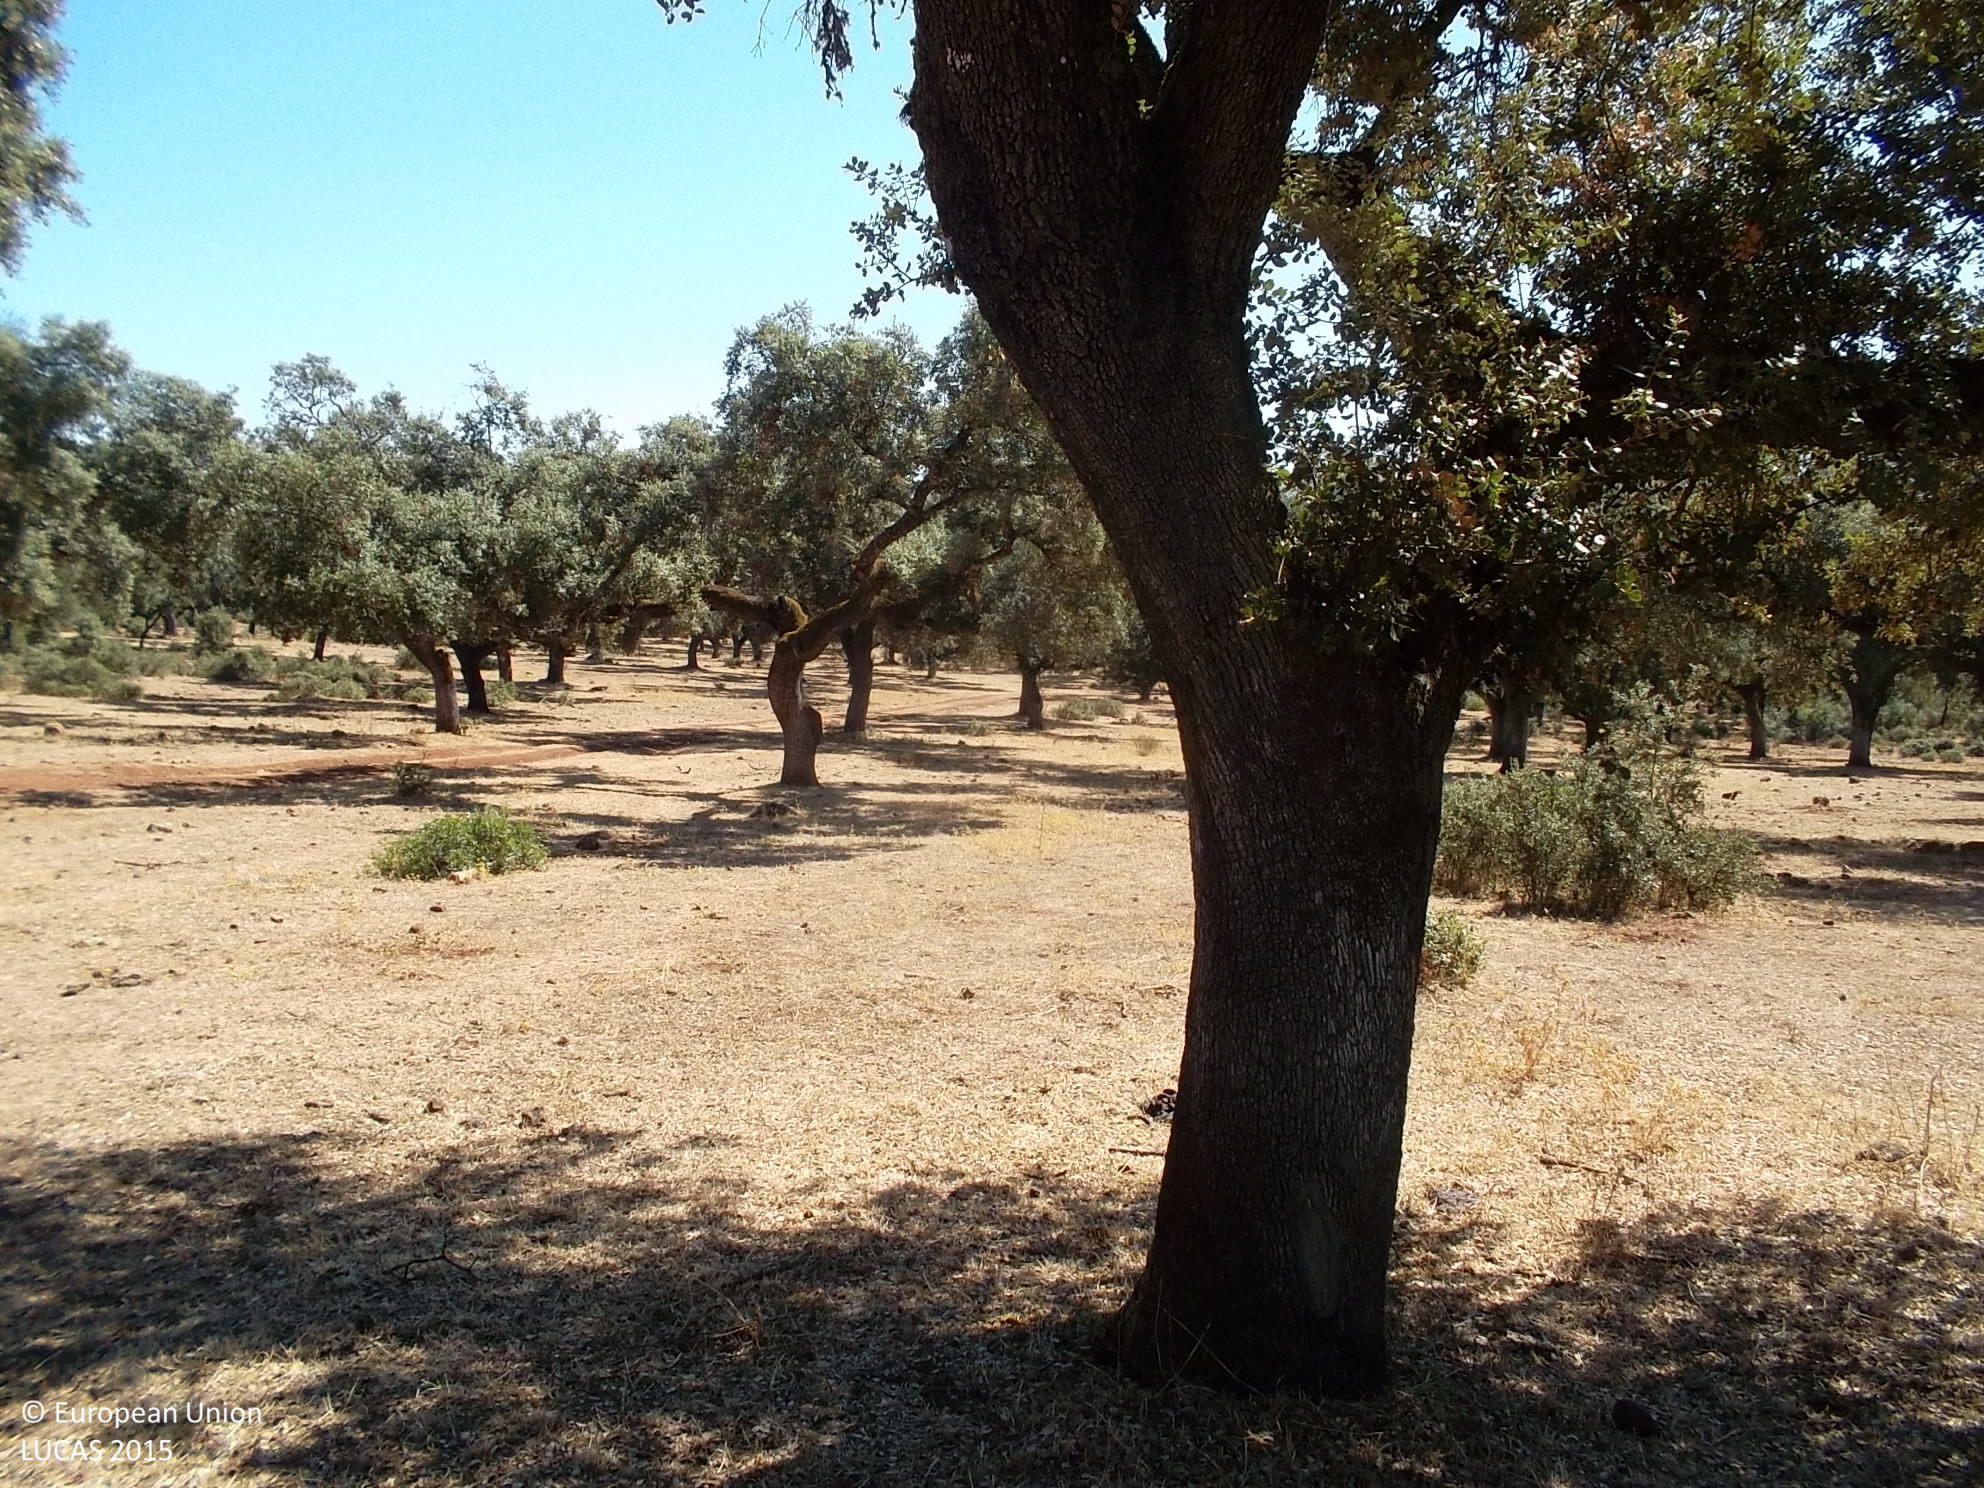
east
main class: Woodland
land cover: Broadleaved woodland
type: broadleaved evergreen forest
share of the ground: 50 - 75 %
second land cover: Grassland without tree/shrub cover
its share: 50 - 75 %
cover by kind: broadleaved forest trees 50 %, herbaceous plants 50 %
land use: Forestry
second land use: Agriculture (excluding fallow land and kitchen gardens)
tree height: > 5 m
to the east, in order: Broadleaved woodland; Grassland without tree/shrub cover; Tracks; Broadleaved woodland
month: August
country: ES
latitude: 38.2388
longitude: -6.6756
